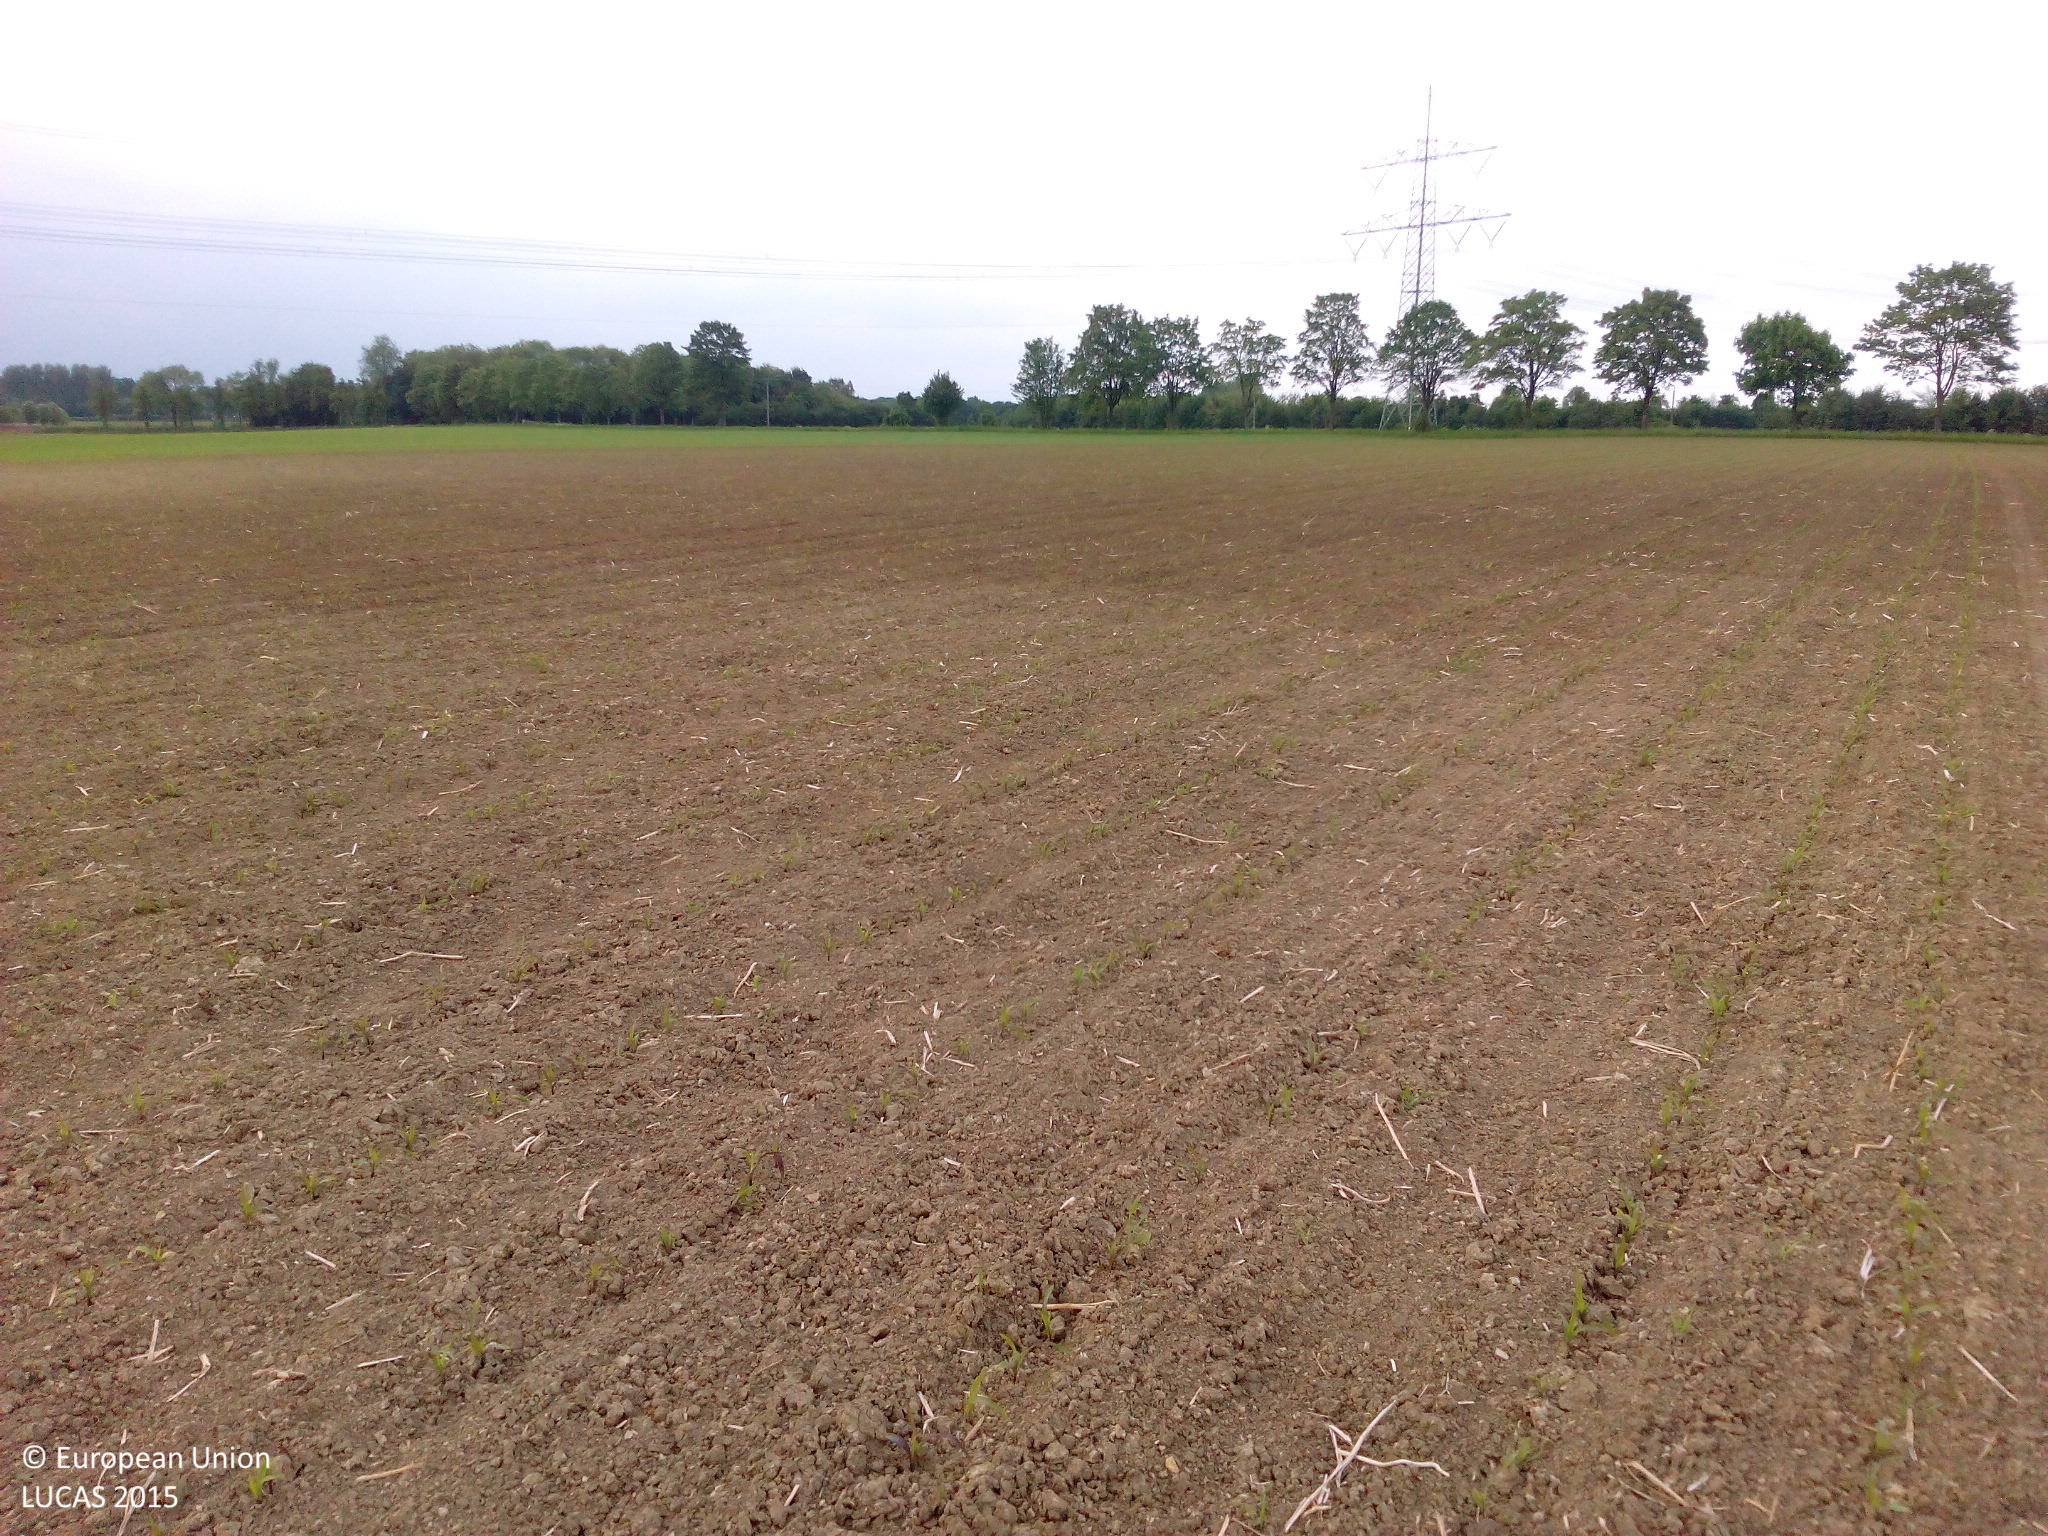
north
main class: Cropland
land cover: Maize
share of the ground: < 10 %
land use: Agriculture (excluding fallow land and kitchen gardens)
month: May
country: DE
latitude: 51.8025
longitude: 7.9556
